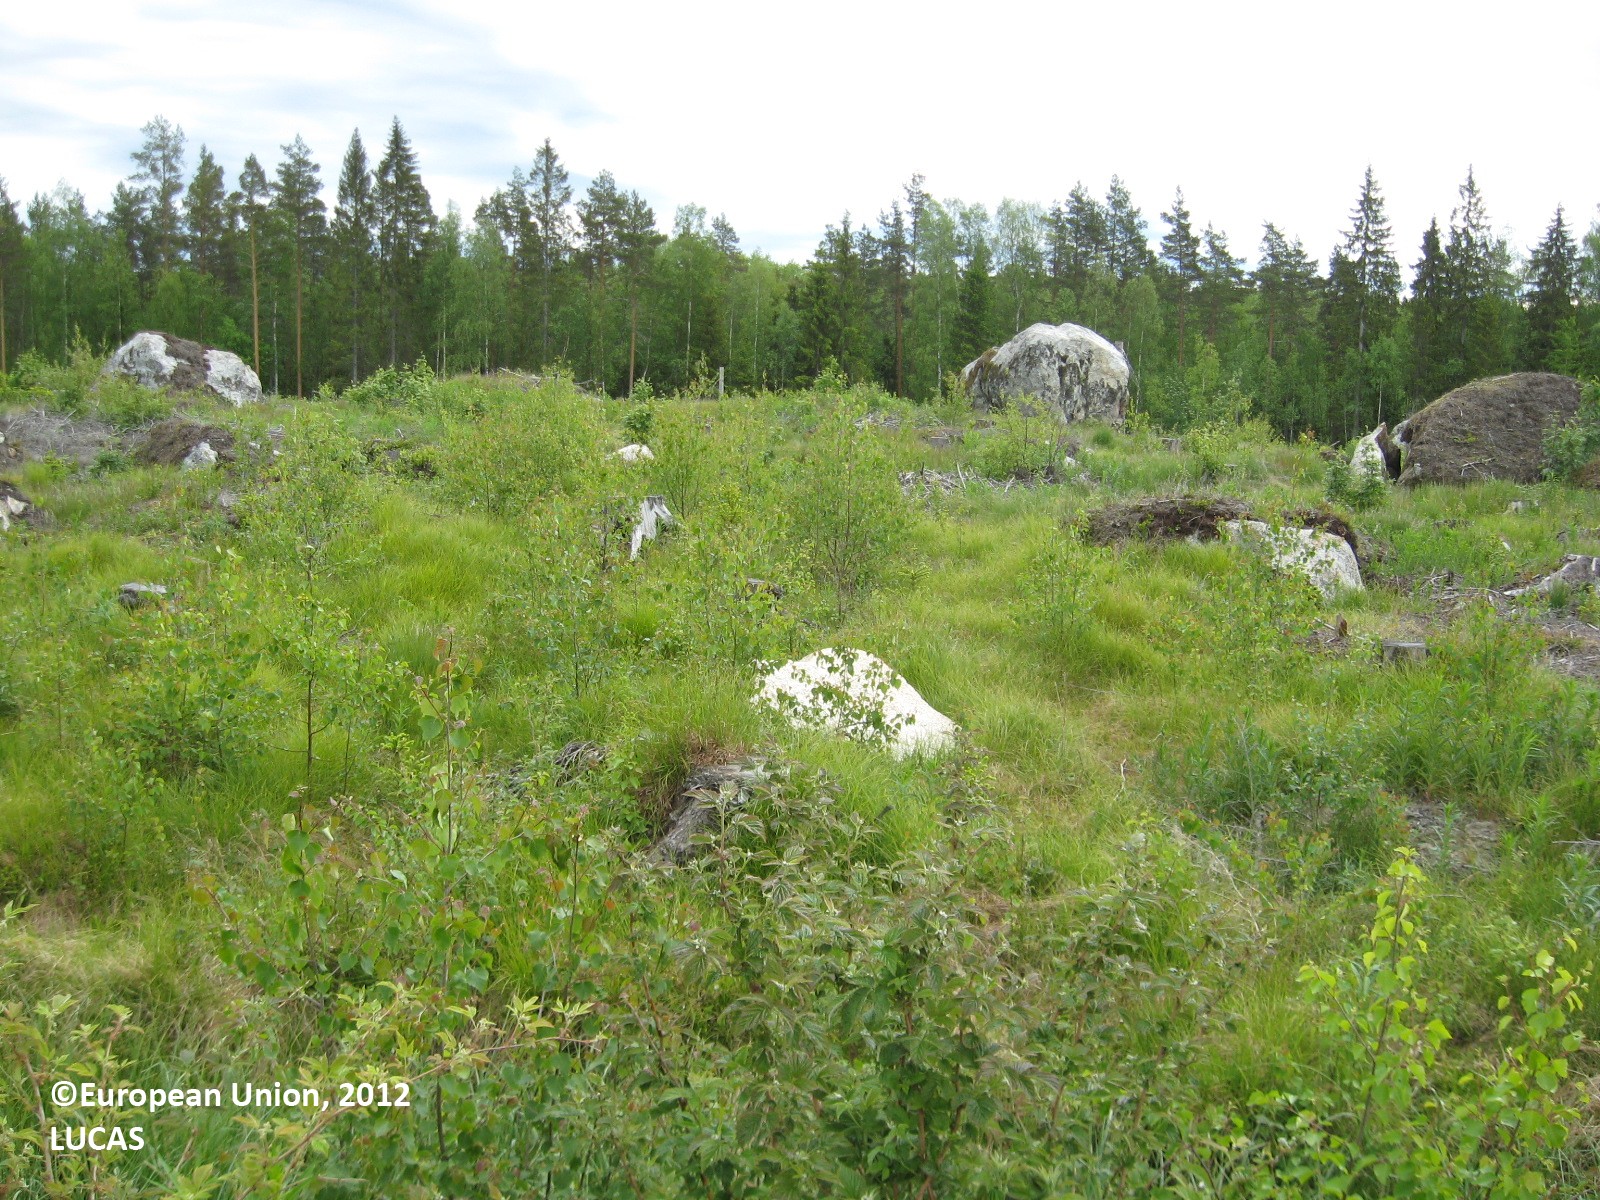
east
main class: Grassland
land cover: Grassland with sparse tree/shrub cover
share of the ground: > 75 %
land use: Forestry
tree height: < 5 m
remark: Clear cut
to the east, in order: Grassland with sparse tree/shrub cover; Ditches and canals; Shrubland without tree cover; Ditches and canals; Shruby margins; Paved roads, cycling and walking lanes; Other mixed woodland; Ditches and canals; Other mixed woodland; Ditches and canals; Spruce dominated mixed woodland; Other mixed woodland
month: June
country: FI
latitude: 63.1033
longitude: 21.9518
